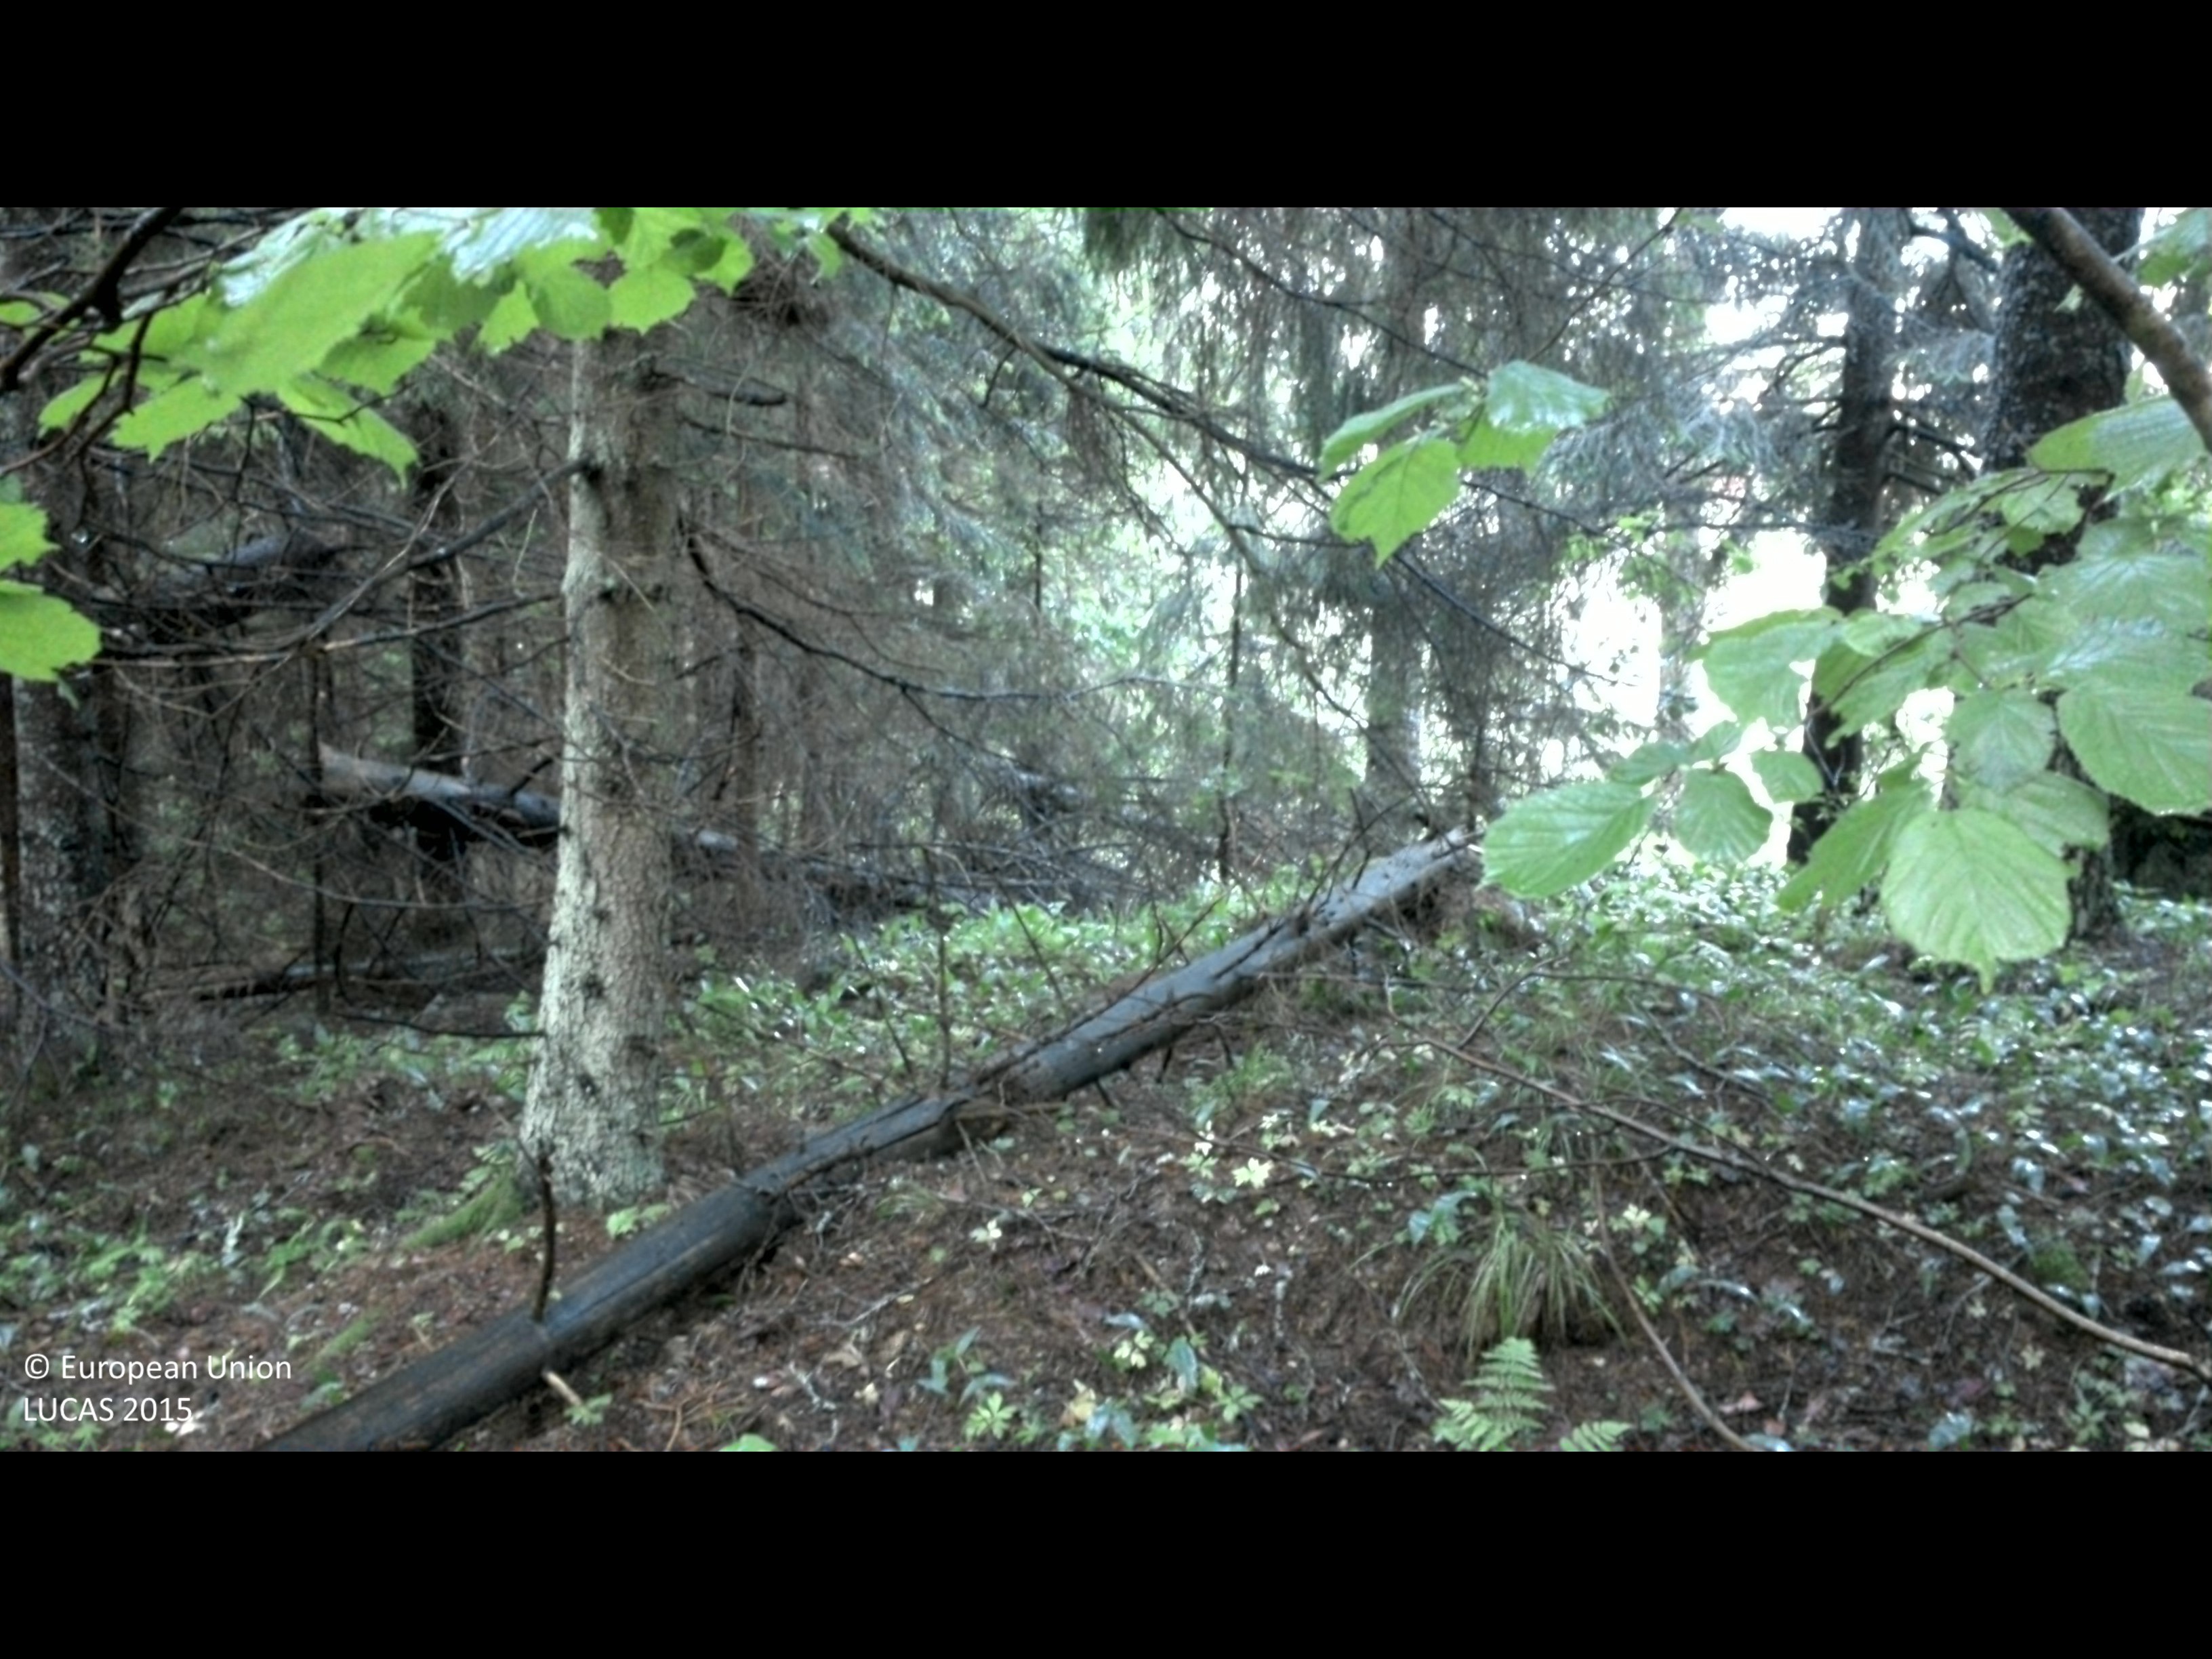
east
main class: Woodland
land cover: Spruce dominated coniferous woodland
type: boreal forest
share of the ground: > 75 %
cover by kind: coniferous forest trees 70 %, broadleaved forest trees 20 %, shrubs 5 %, herbaceous plants 5 %
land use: Forestry
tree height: > 5 m
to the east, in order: Spruce dominated coniferous woodland; Fences; Spruce dominated mixed woodland; Ditches and canals; Broadleaved woodland; Grassland without tree/shrub cover; Fences; Grassland with sparse tree/shrub cover; Grassland without tree/shrub cover; Fences; Paved roads, cycling and walking lanes
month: June
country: SE
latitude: 58.0787
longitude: 16.1518
